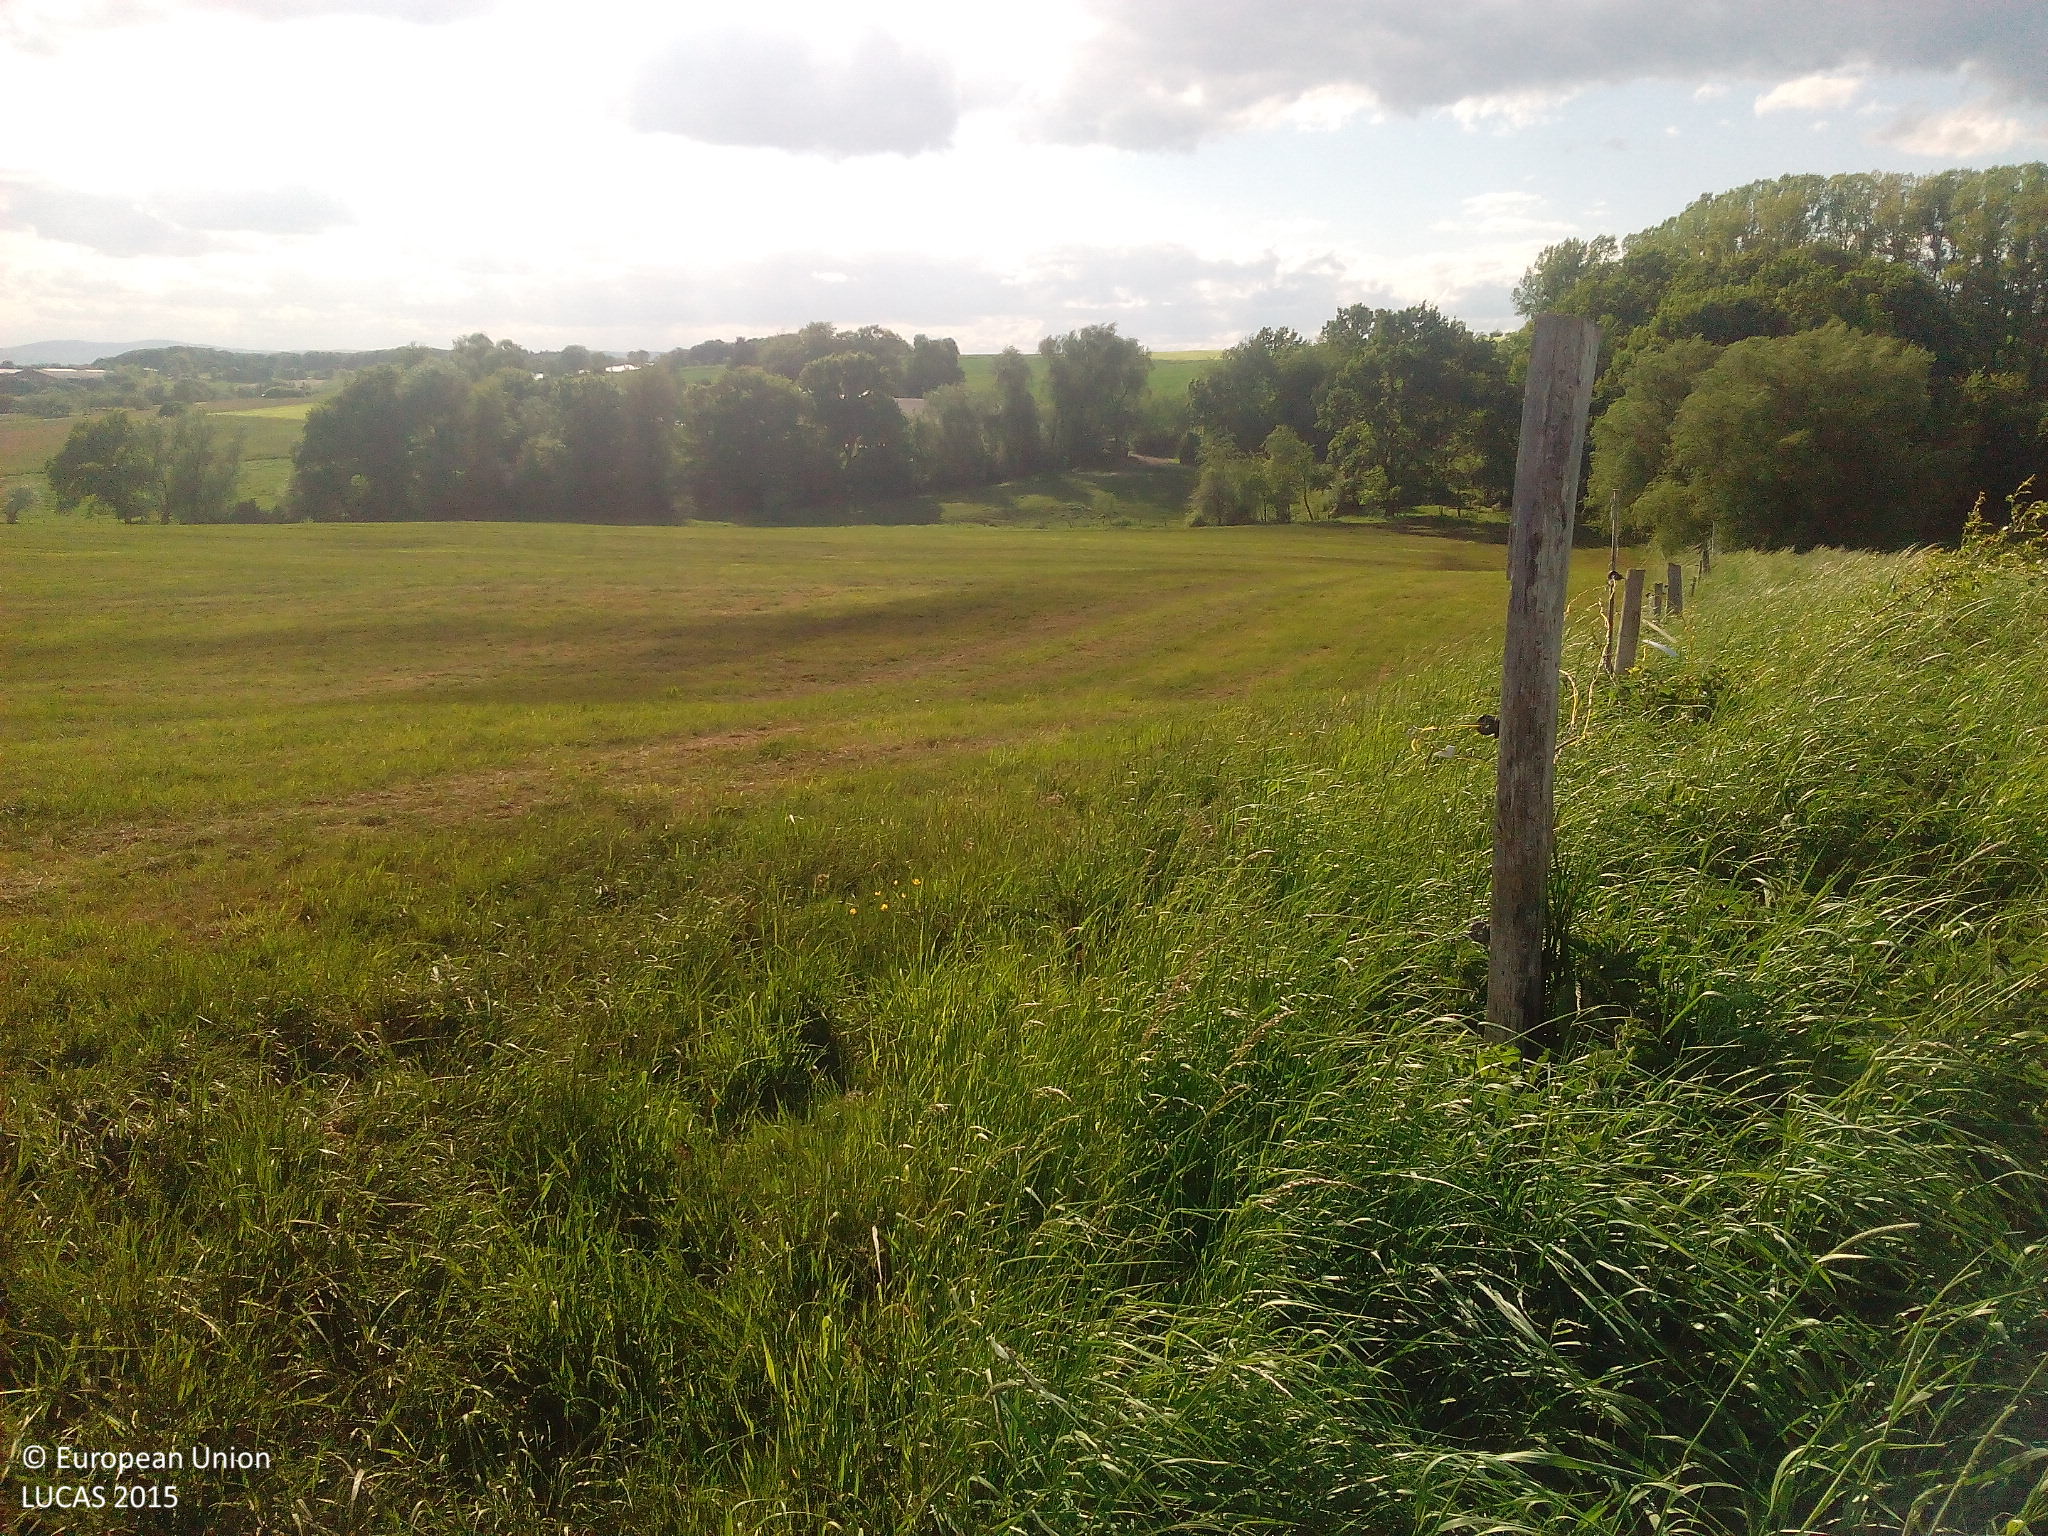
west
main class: Grassland
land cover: Grassland without tree/shrub cover
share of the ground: > 75 %
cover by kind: herbaceous plants 100 %
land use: Agriculture (excluding fallow land and kitchen gardens)
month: May
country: DE
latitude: 51.2984
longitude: 9.6416
